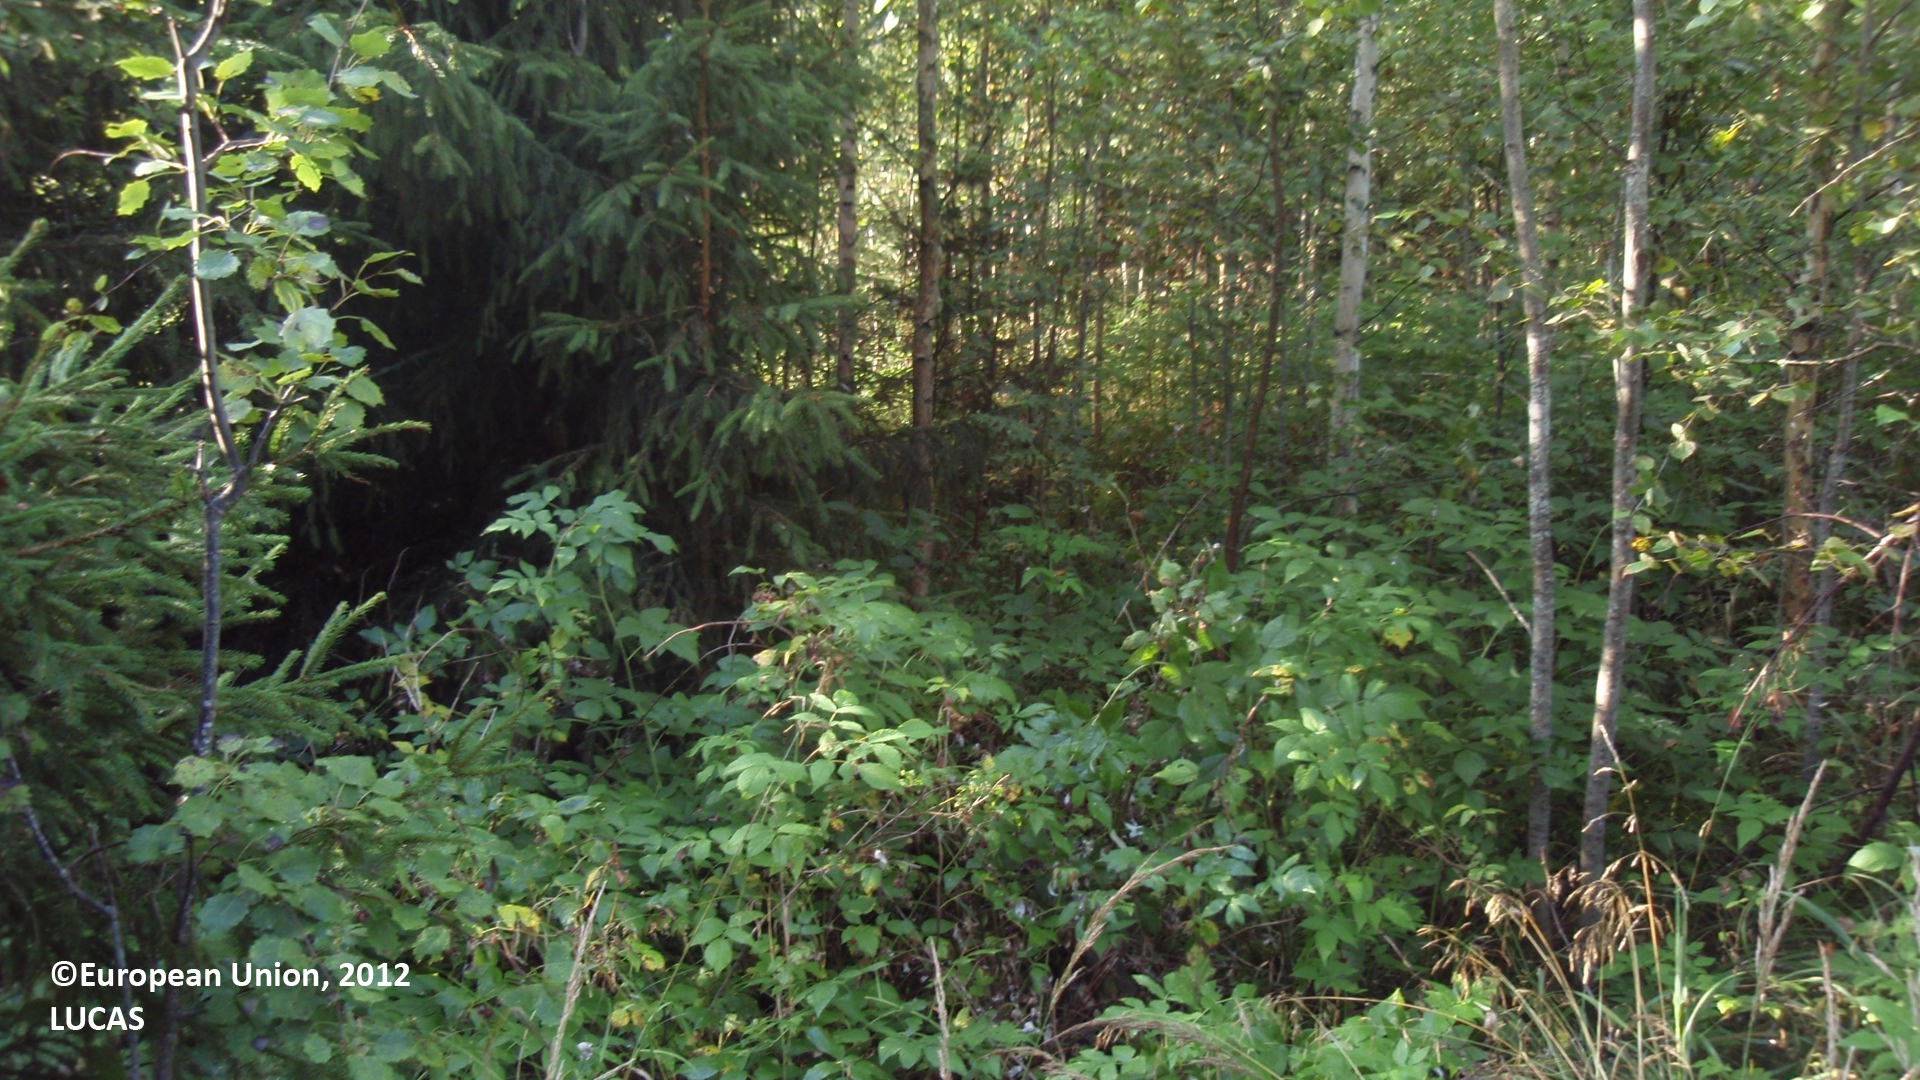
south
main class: Woodland
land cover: Broadleaved woodland
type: boreal forest
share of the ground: 50 - 75 %
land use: Forestry
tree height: > 5 m
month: August
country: FI
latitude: 60.6205
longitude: 27.2636
